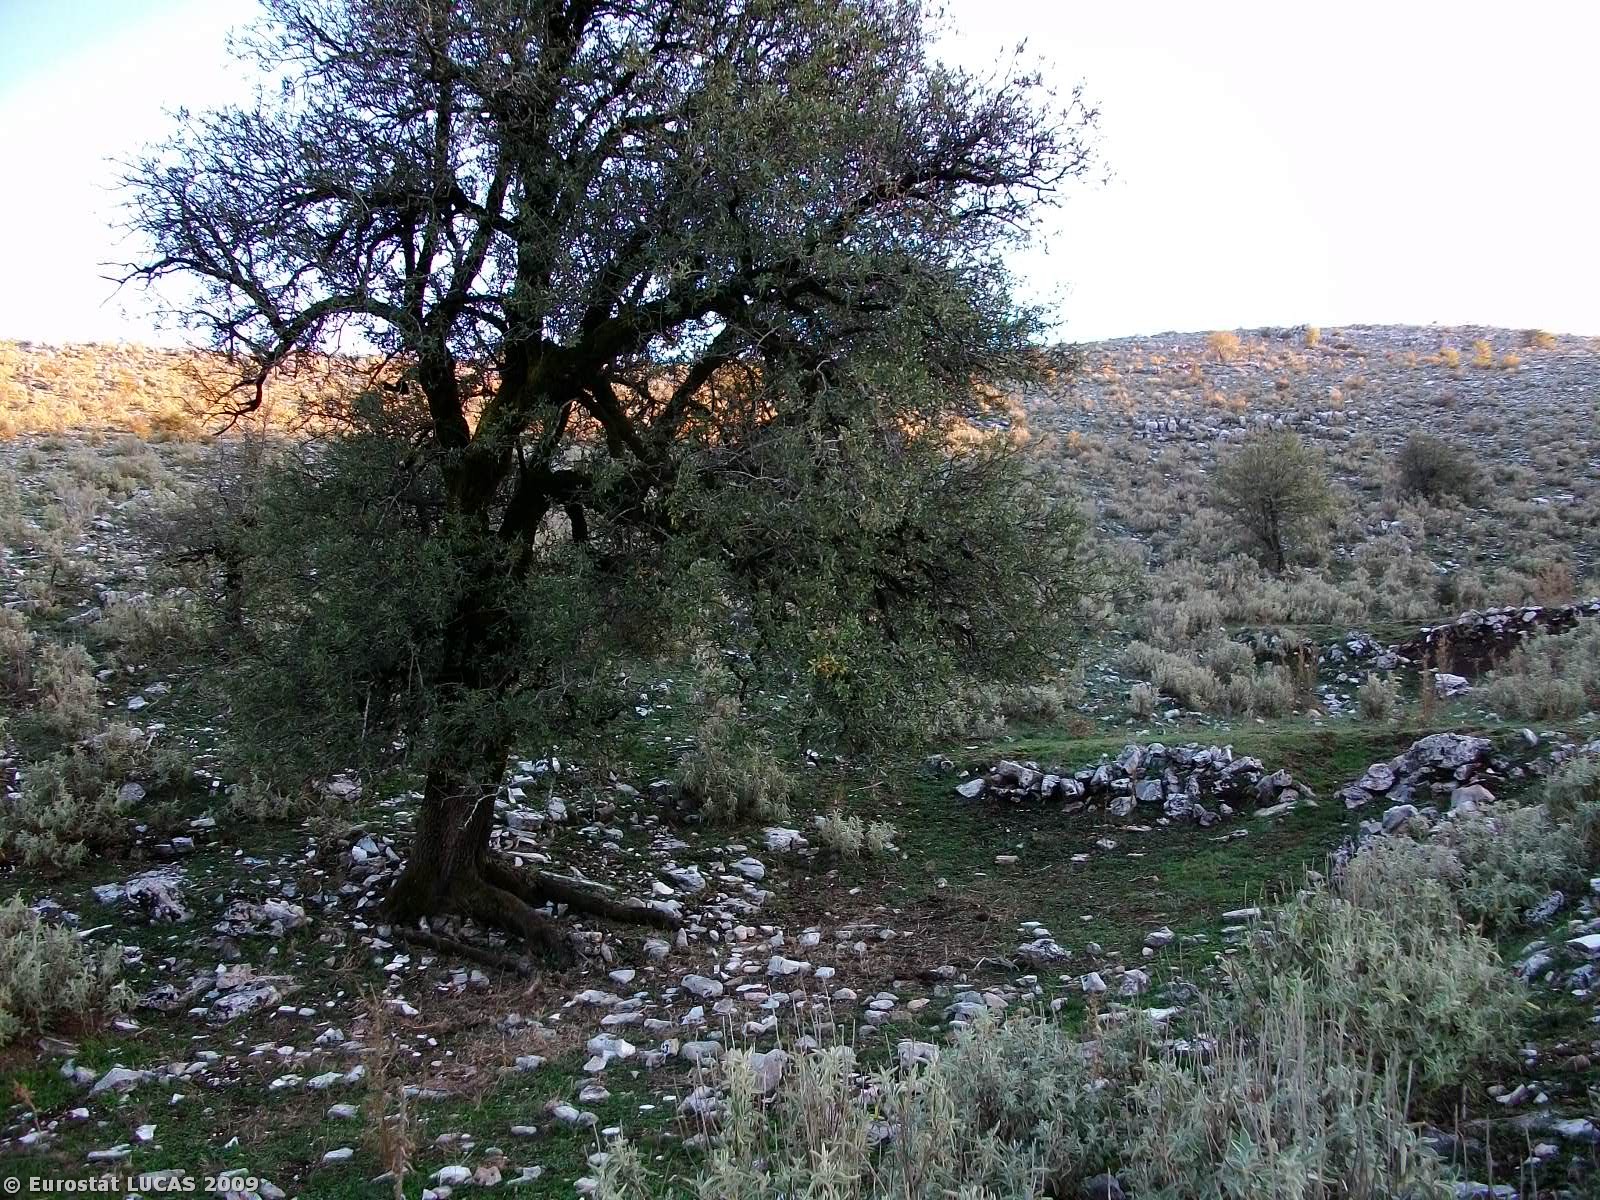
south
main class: Shrubland
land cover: Shrubland without tree cover
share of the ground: 50 - 75 %
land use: Agriculture (excluding fallow land and kitchen gardens)
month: October
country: GR
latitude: 39.6723
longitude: 20.2694
